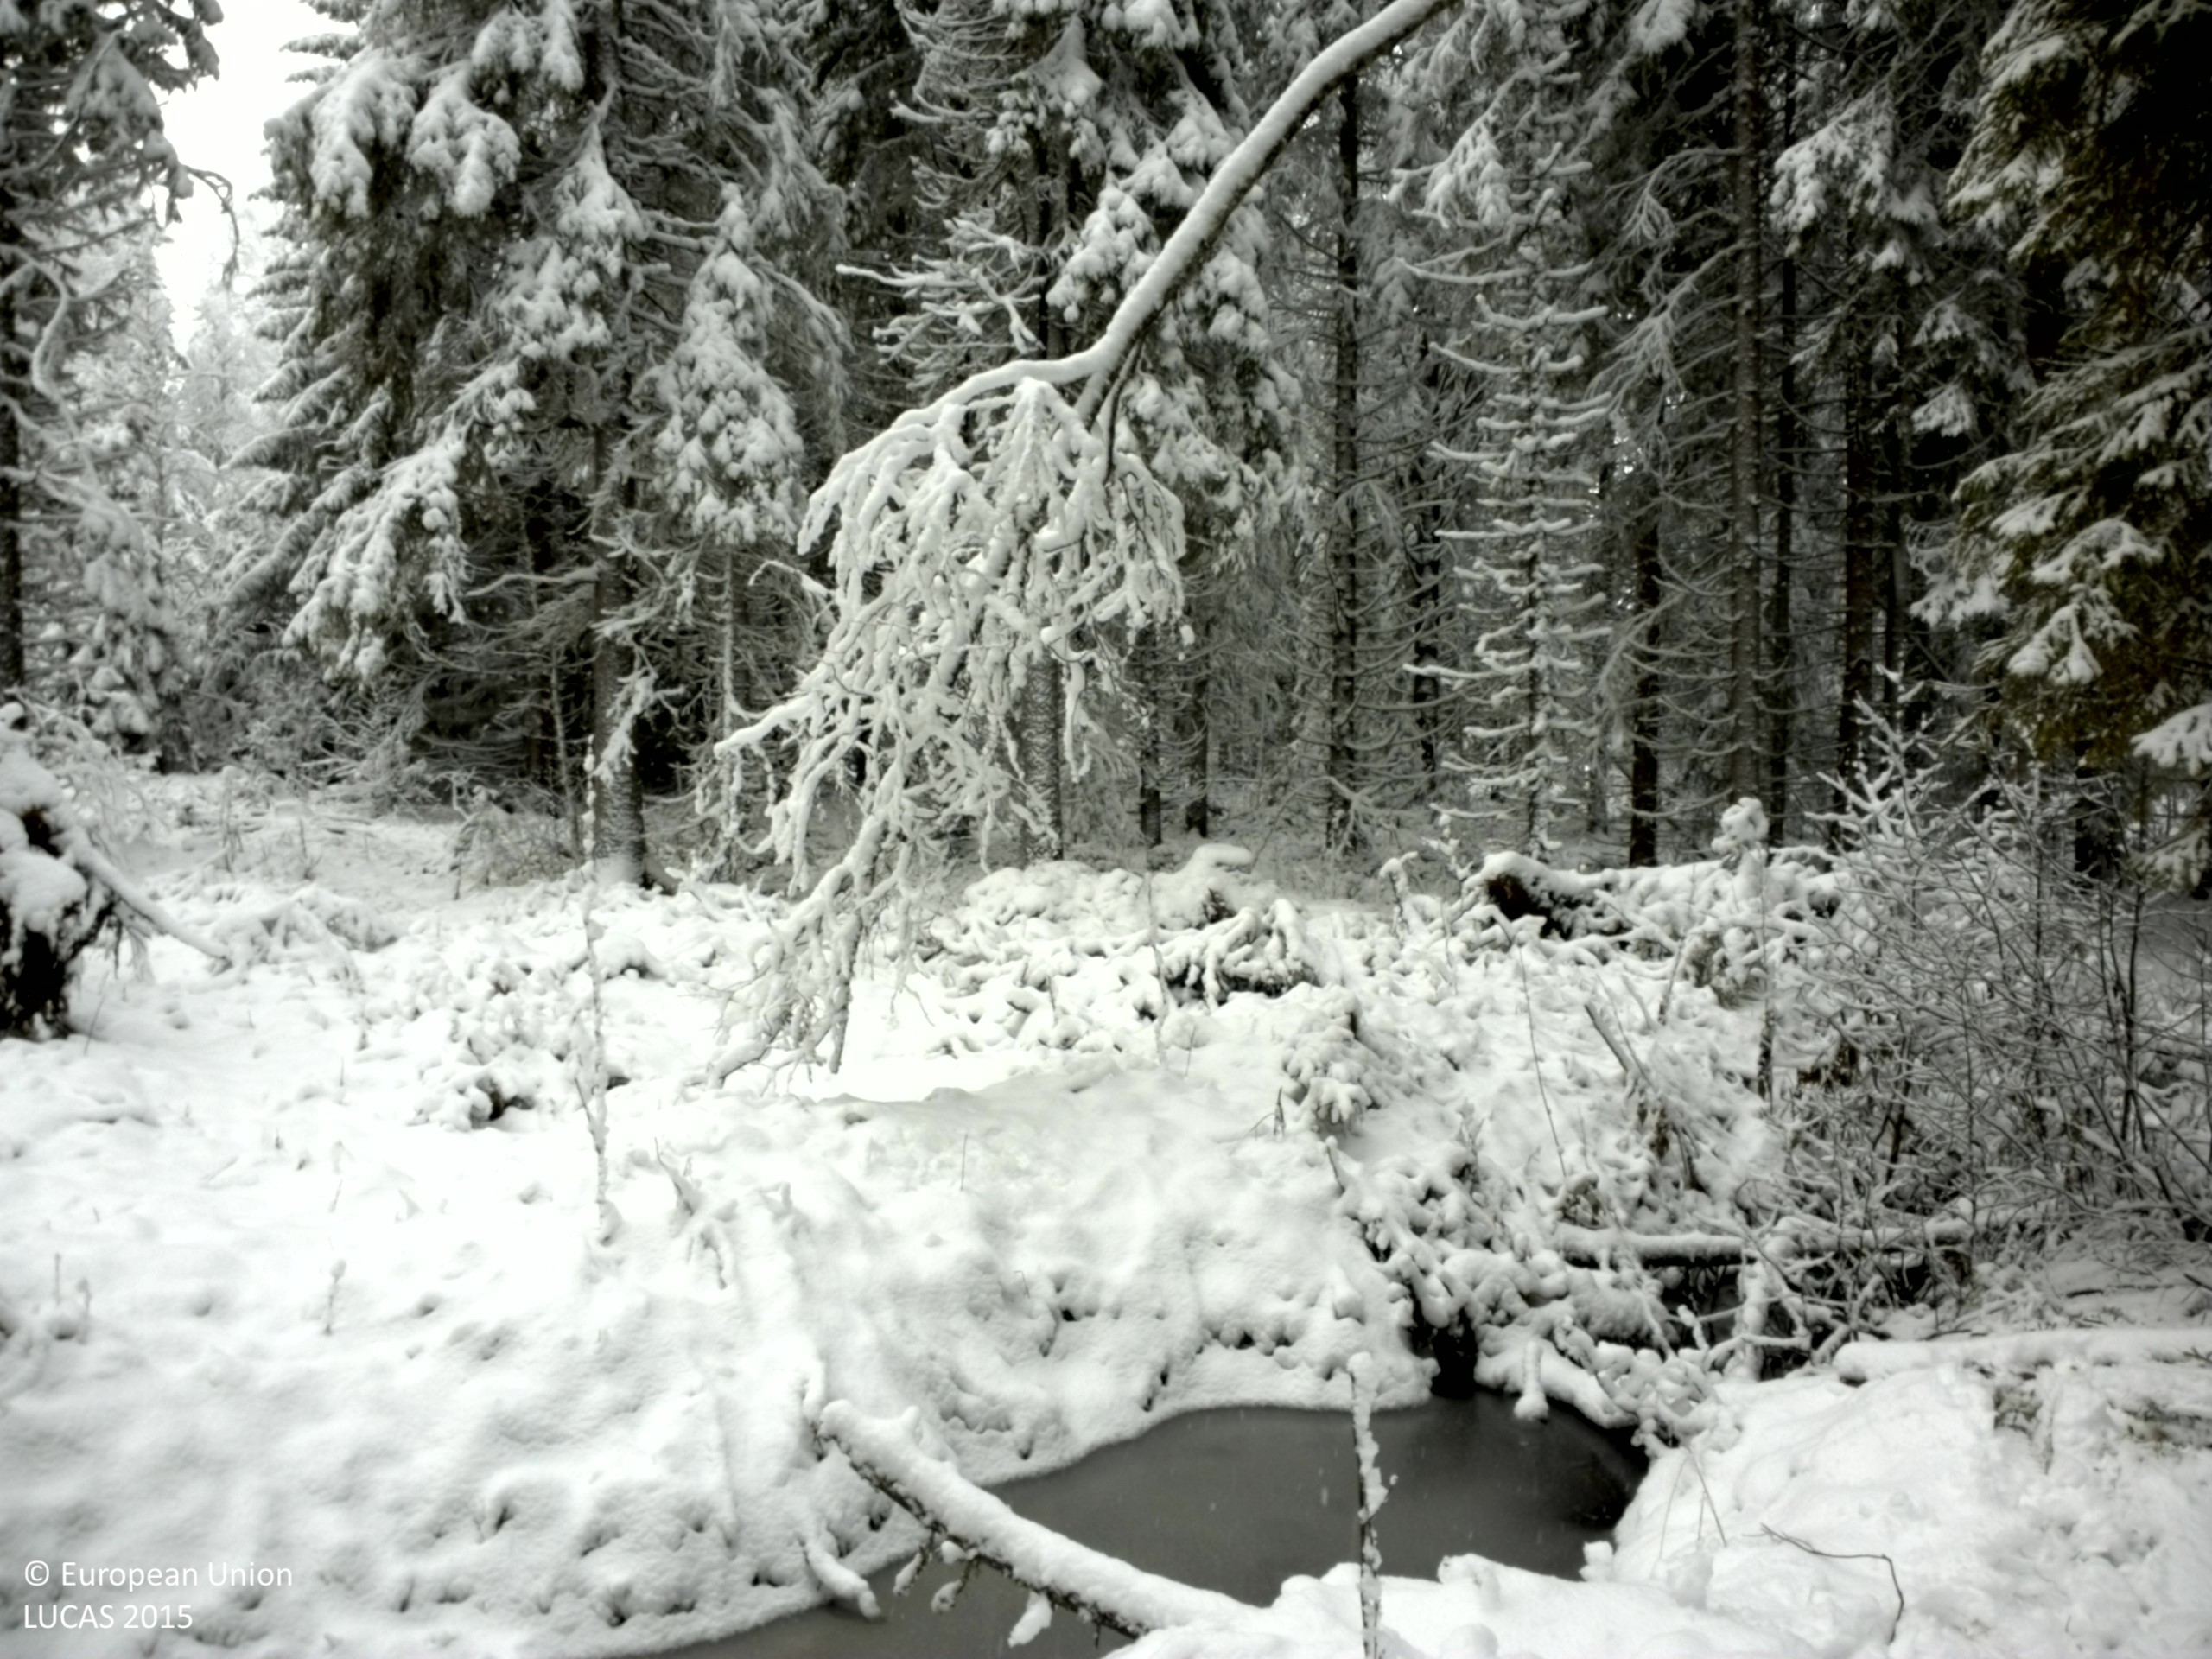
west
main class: Woodland
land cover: Spruce dominated coniferous woodland
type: boreal forest
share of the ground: > 75 %
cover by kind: coniferous forest trees 70 %, shrubs 15 %, lichens and mosses 10 %, broadleaved forest trees 5 %
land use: Forestry
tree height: > 5 m
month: November
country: SE
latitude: 63.7430
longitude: 15.4645
